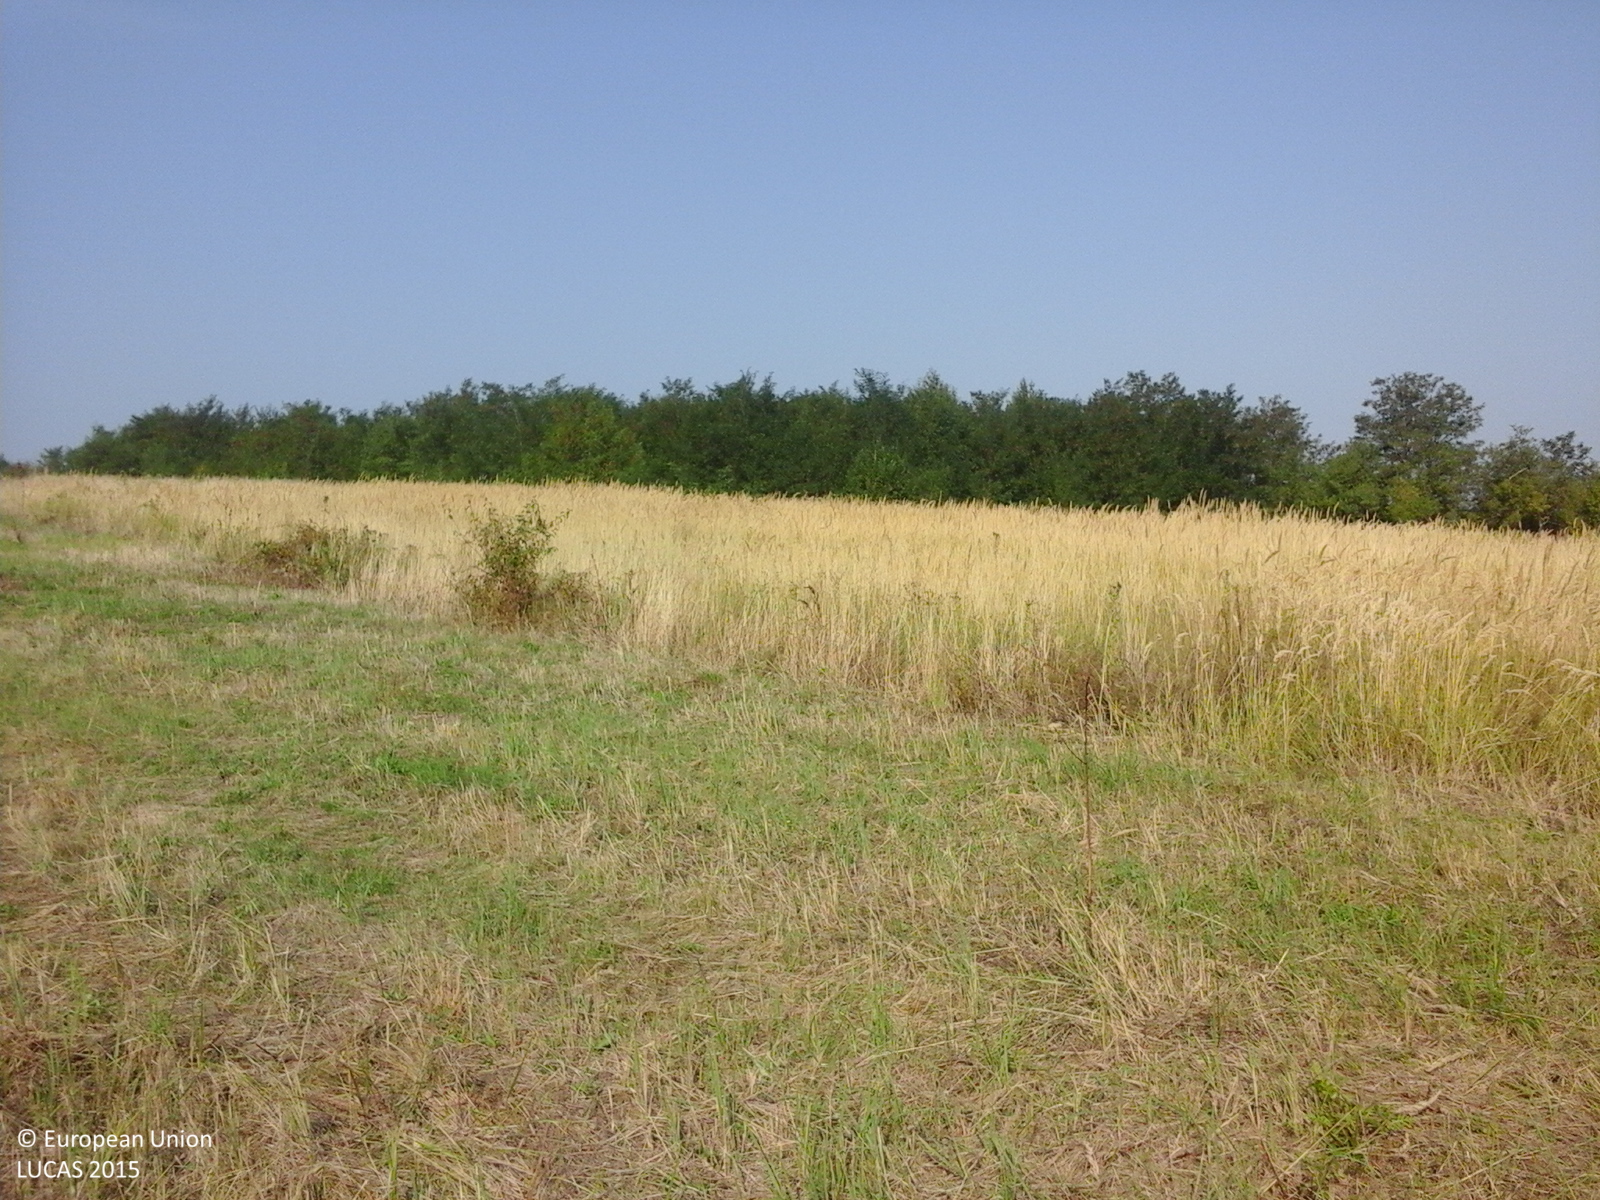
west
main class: Grassland
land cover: Grassland without tree/shrub cover
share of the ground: > 75 %
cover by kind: herbaceous plants 100 %
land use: Agriculture (excluding fallow land and kitchen gardens)
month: August
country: RO
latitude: 46.3009
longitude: 22.0795
